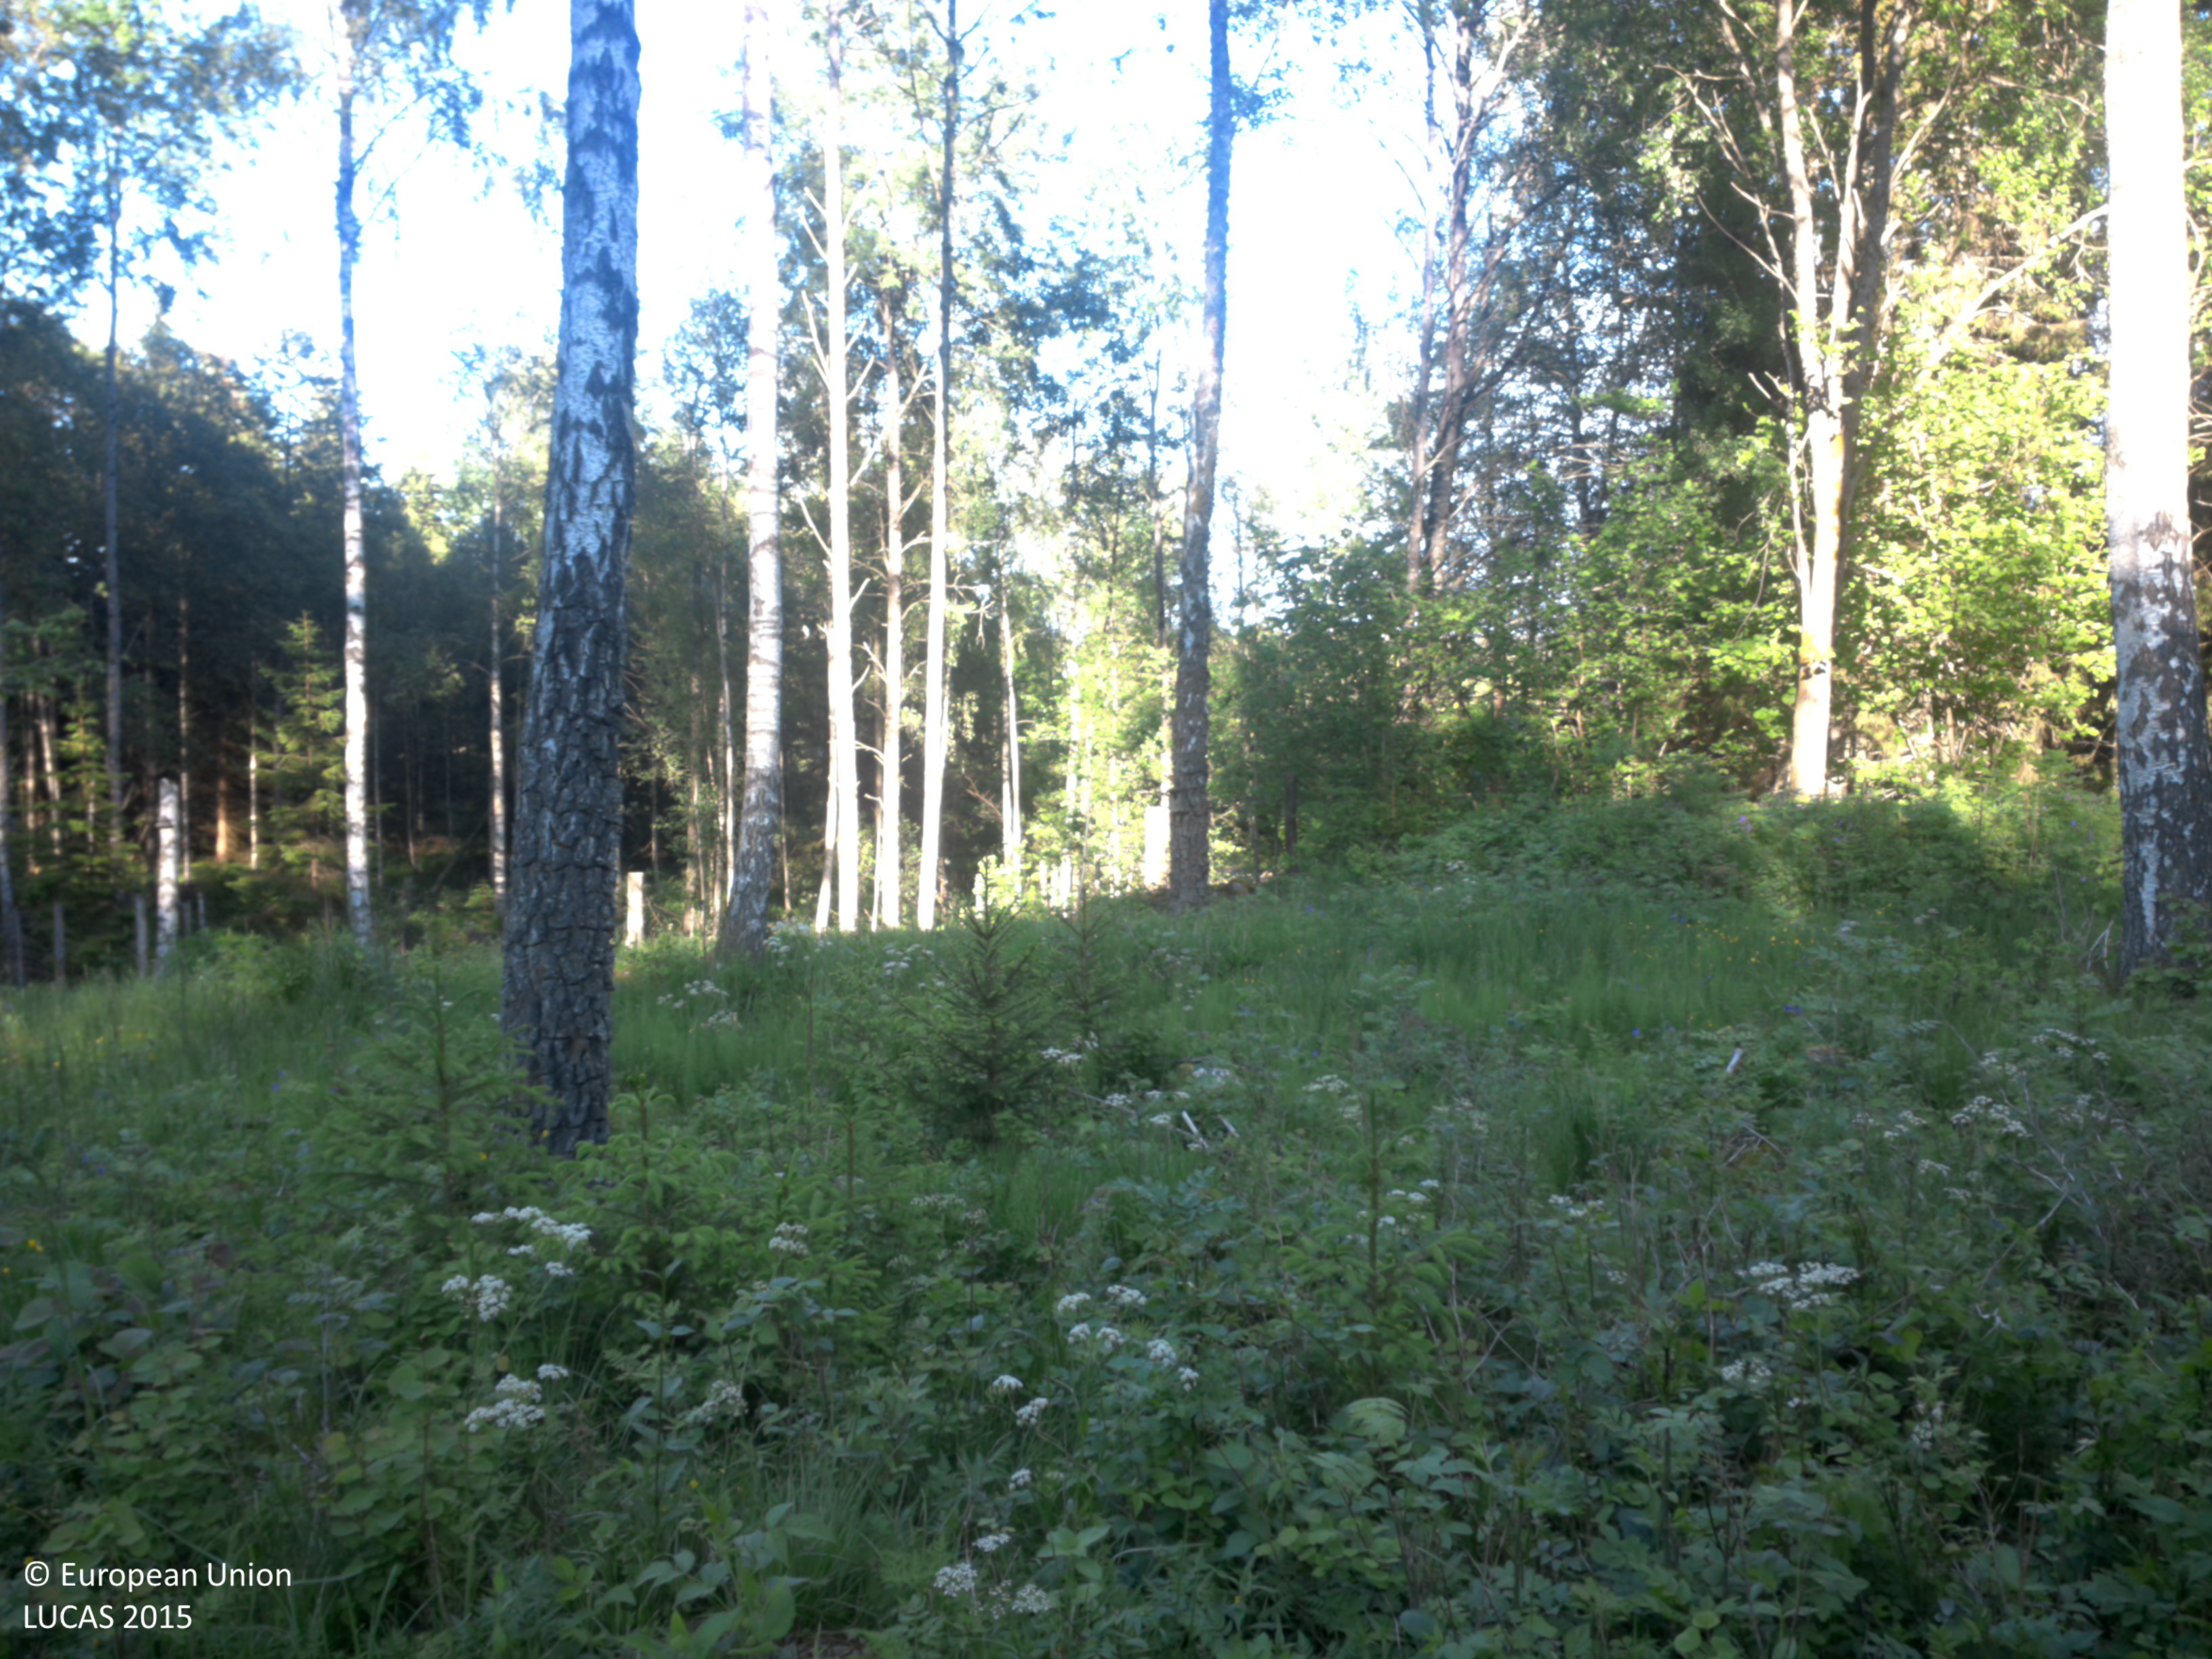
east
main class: Woodland
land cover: Broadleaved woodland
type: hemiboreal forest and nemoral coniferous forest and mixed broadleaved-coniferous forest
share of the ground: 10 - 25 %
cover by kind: herbaceous plants 70 %, broadleaved forest trees 15 %, shrubs 15 %
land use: Forestry
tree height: > 5 m
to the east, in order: Broadleaved woodland; Rivers and streams; Paved roads, cycling and walking lanes; Spruce dominated mixed woodland; Shrubland with sparse tree cover; Electric lines; Shrubland with sparse tree cover; Spruce dominated mixed woodland; Broadleaved woodland; Rivers and streams; Broadleaved woodland; Ditches and canals; Paved roads, cycling and walking lanes
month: June
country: SE
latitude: 58.9619
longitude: 11.8909
